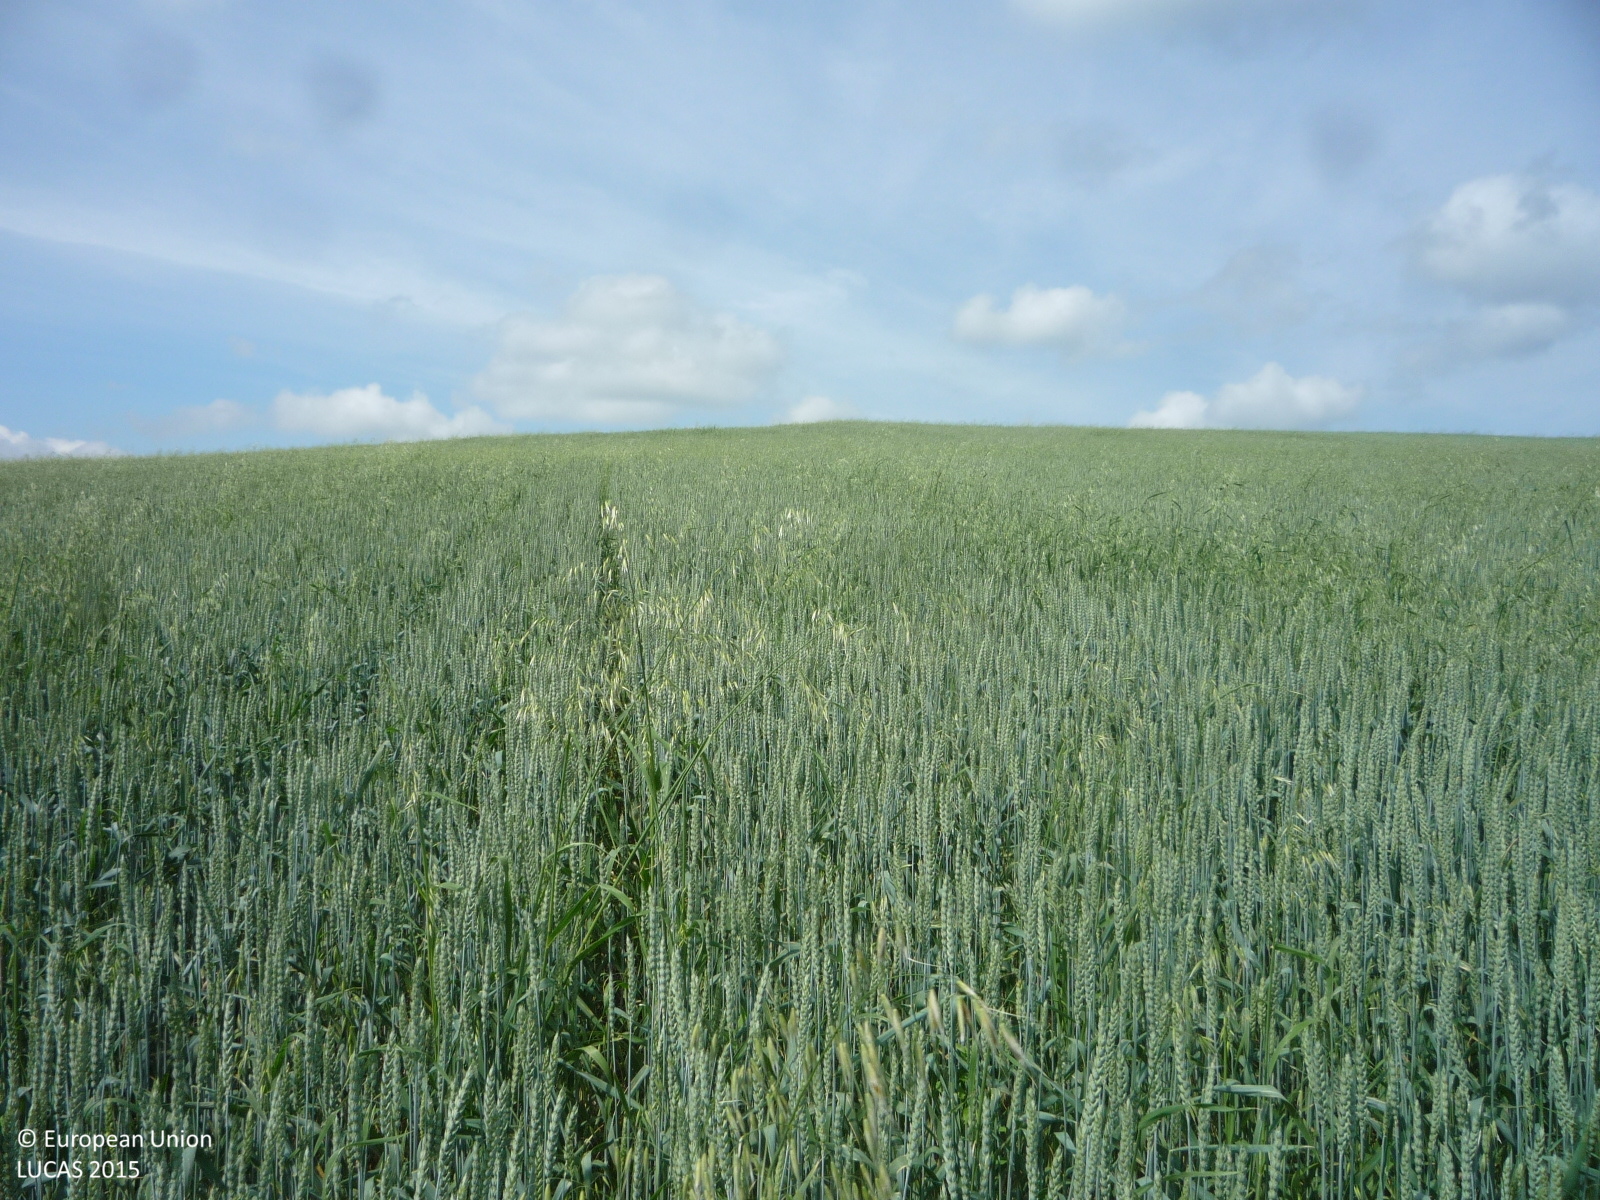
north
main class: Cropland
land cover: Common wheat
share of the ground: > 75 %
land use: Agriculture (excluding fallow land and kitchen gardens)
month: June
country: CZ
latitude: 50.4066
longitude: 13.8702
